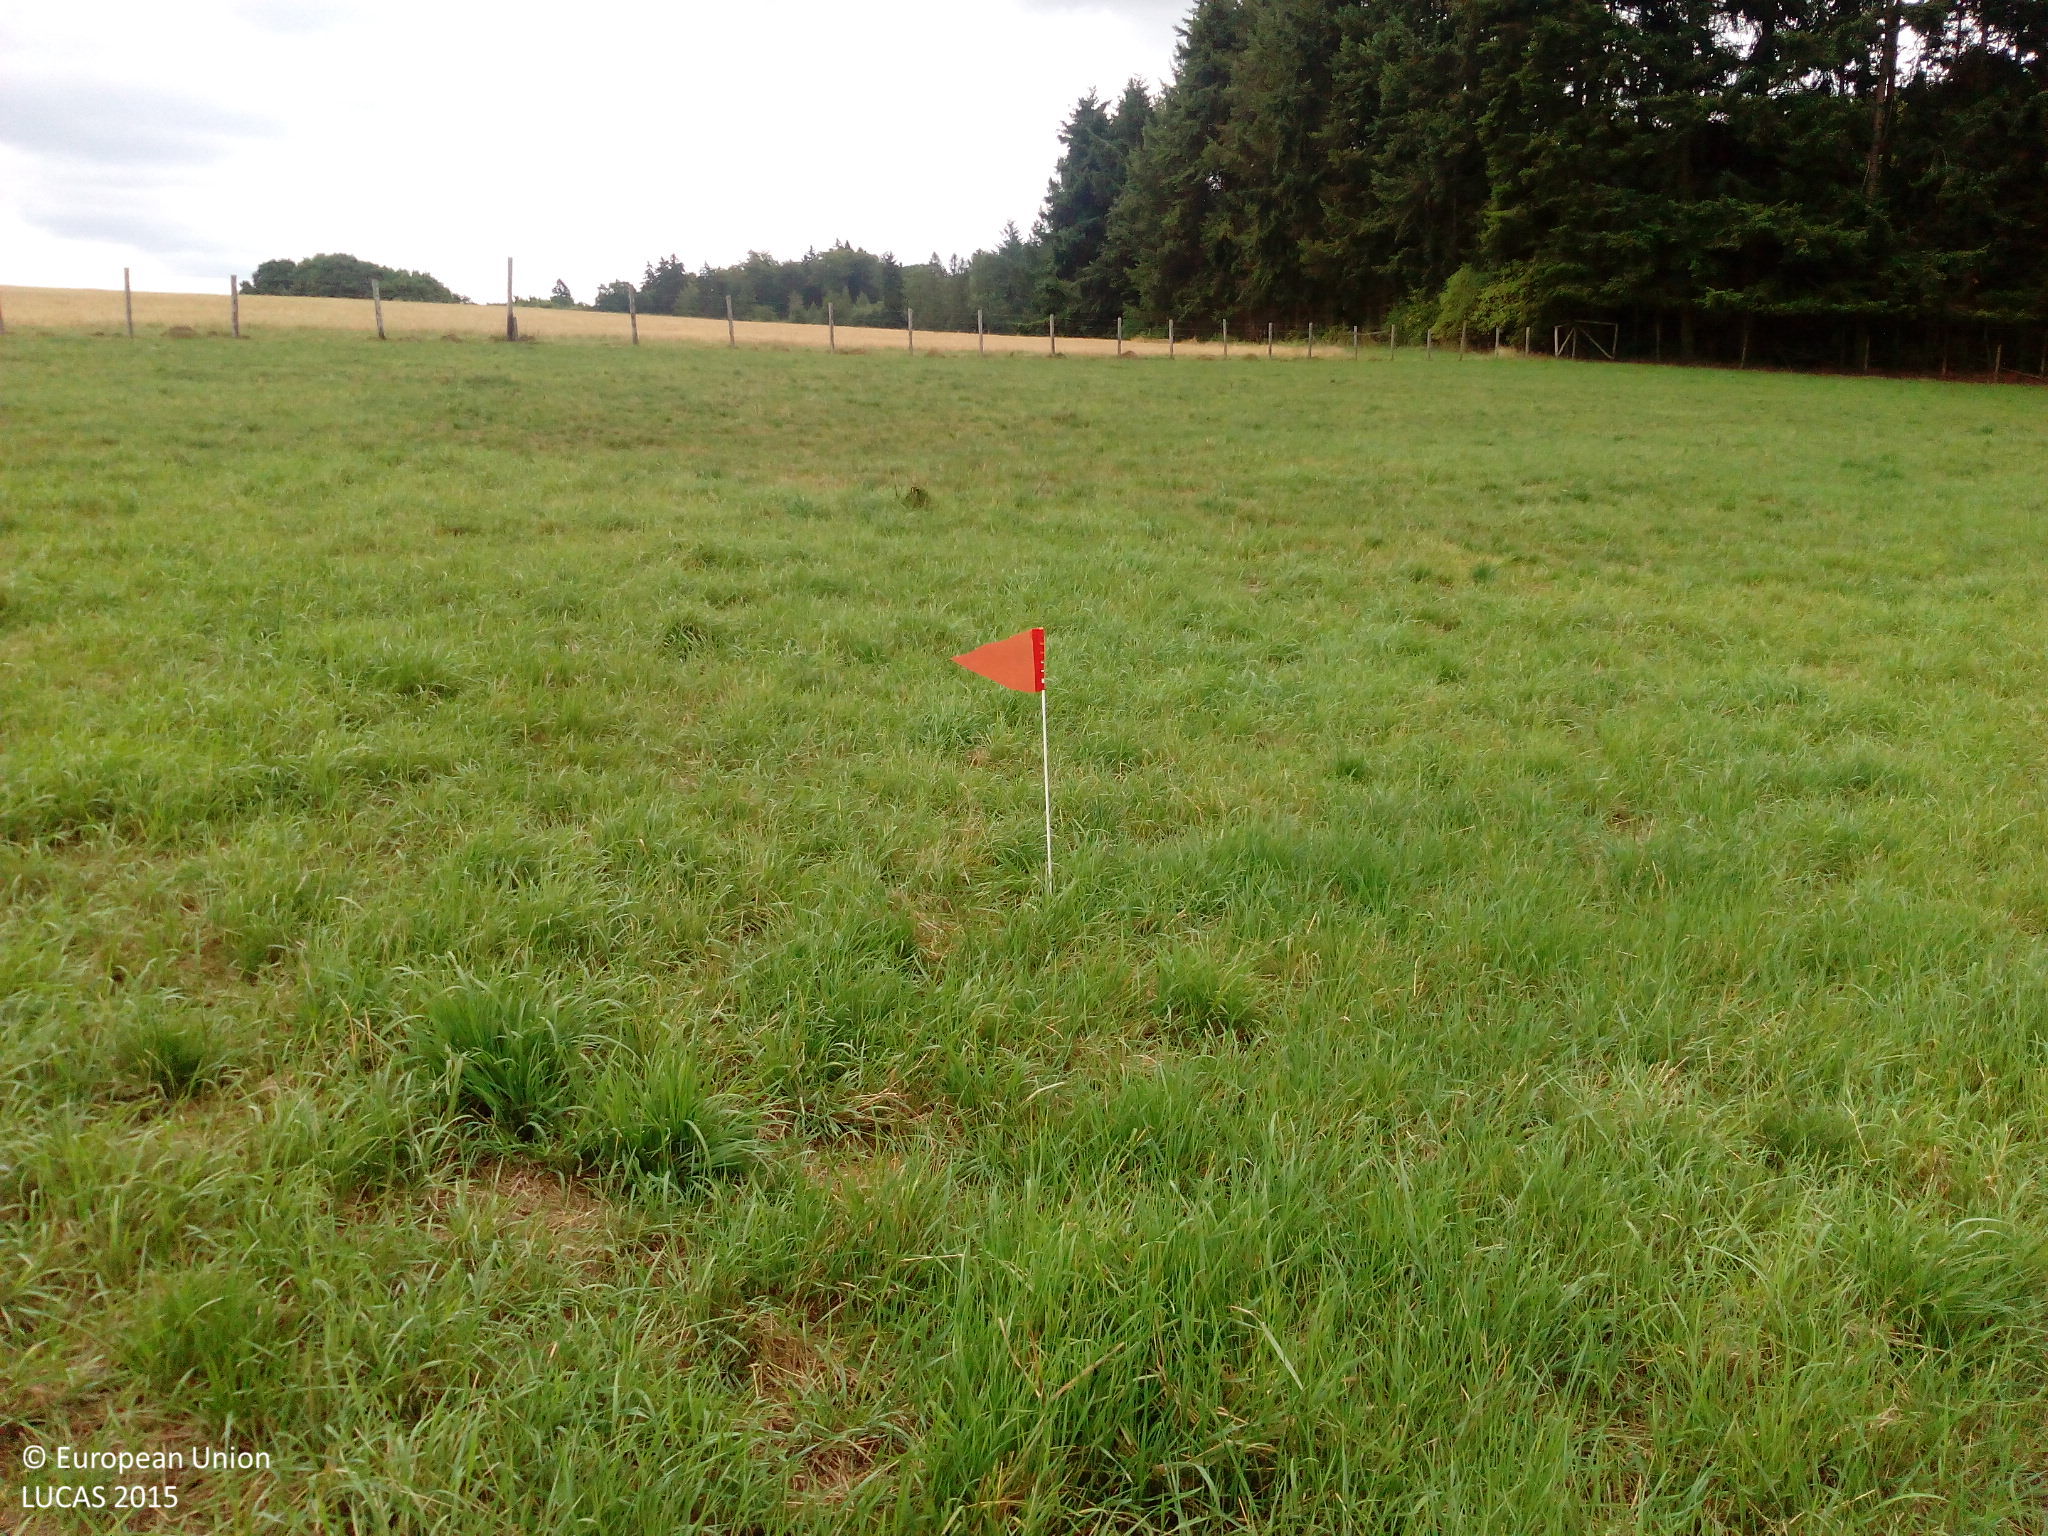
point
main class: Grassland
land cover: Grassland without tree/shrub cover
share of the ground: > 75 %
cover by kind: herbaceous plants 95 %, unconsolidated bare surface 5 %
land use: Agriculture (excluding fallow land and kitchen gardens)
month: August
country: DE
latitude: 50.0489
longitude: 7.5005
